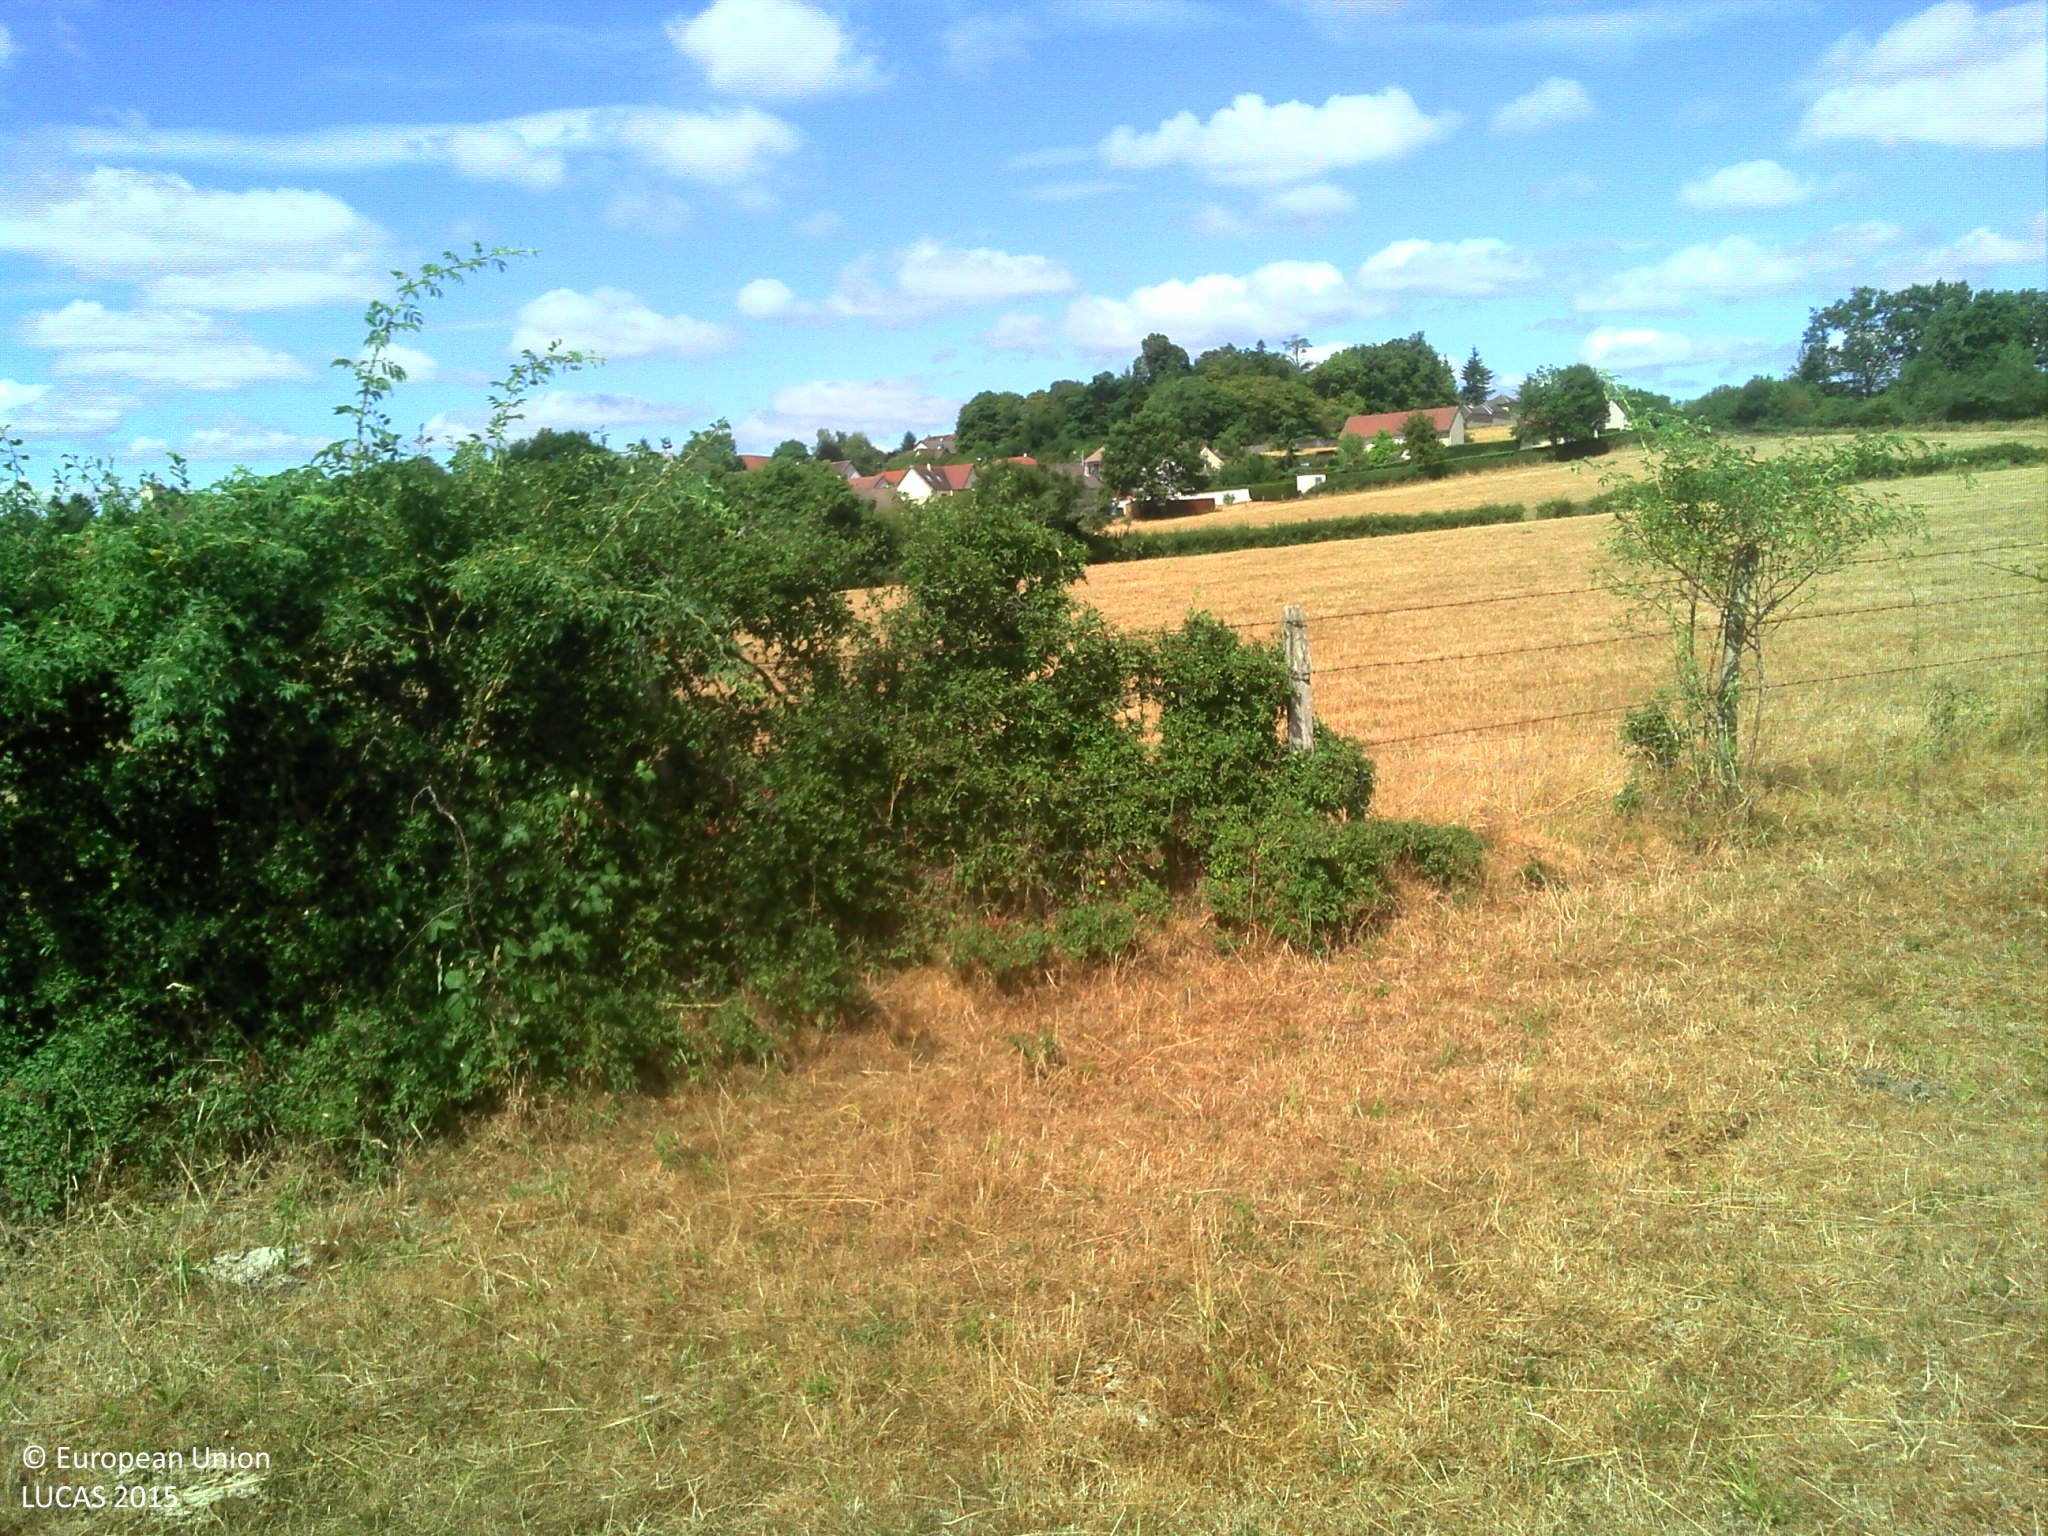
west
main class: Grassland
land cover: Grassland without tree/shrub cover
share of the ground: > 75 %
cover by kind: herbaceous plants 100 %
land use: Agriculture (excluding fallow land and kitchen gardens)
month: July
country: FR
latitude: 46.8418
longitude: 4.5064
